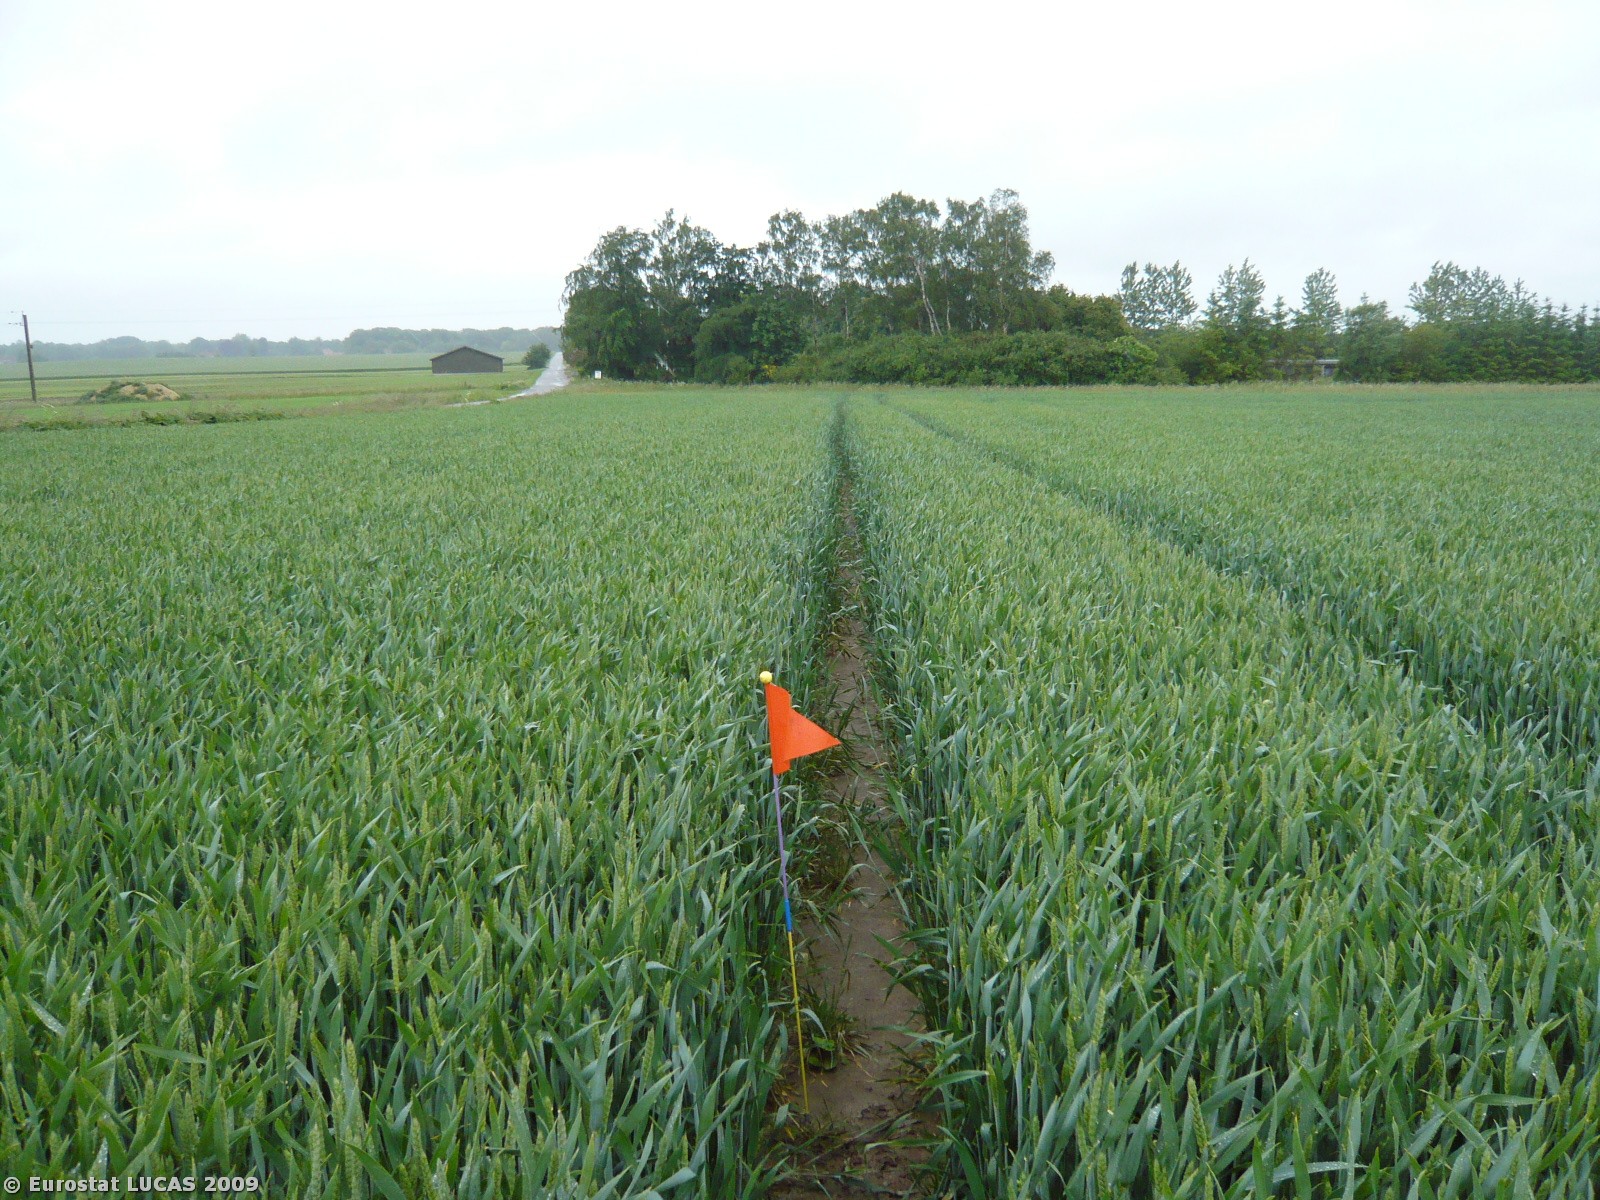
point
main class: Cropland
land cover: Common wheat
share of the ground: > 75 %
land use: Agriculture (excluding fallow land and kitchen gardens)
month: June
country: DK
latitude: 54.7707
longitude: 11.9418
